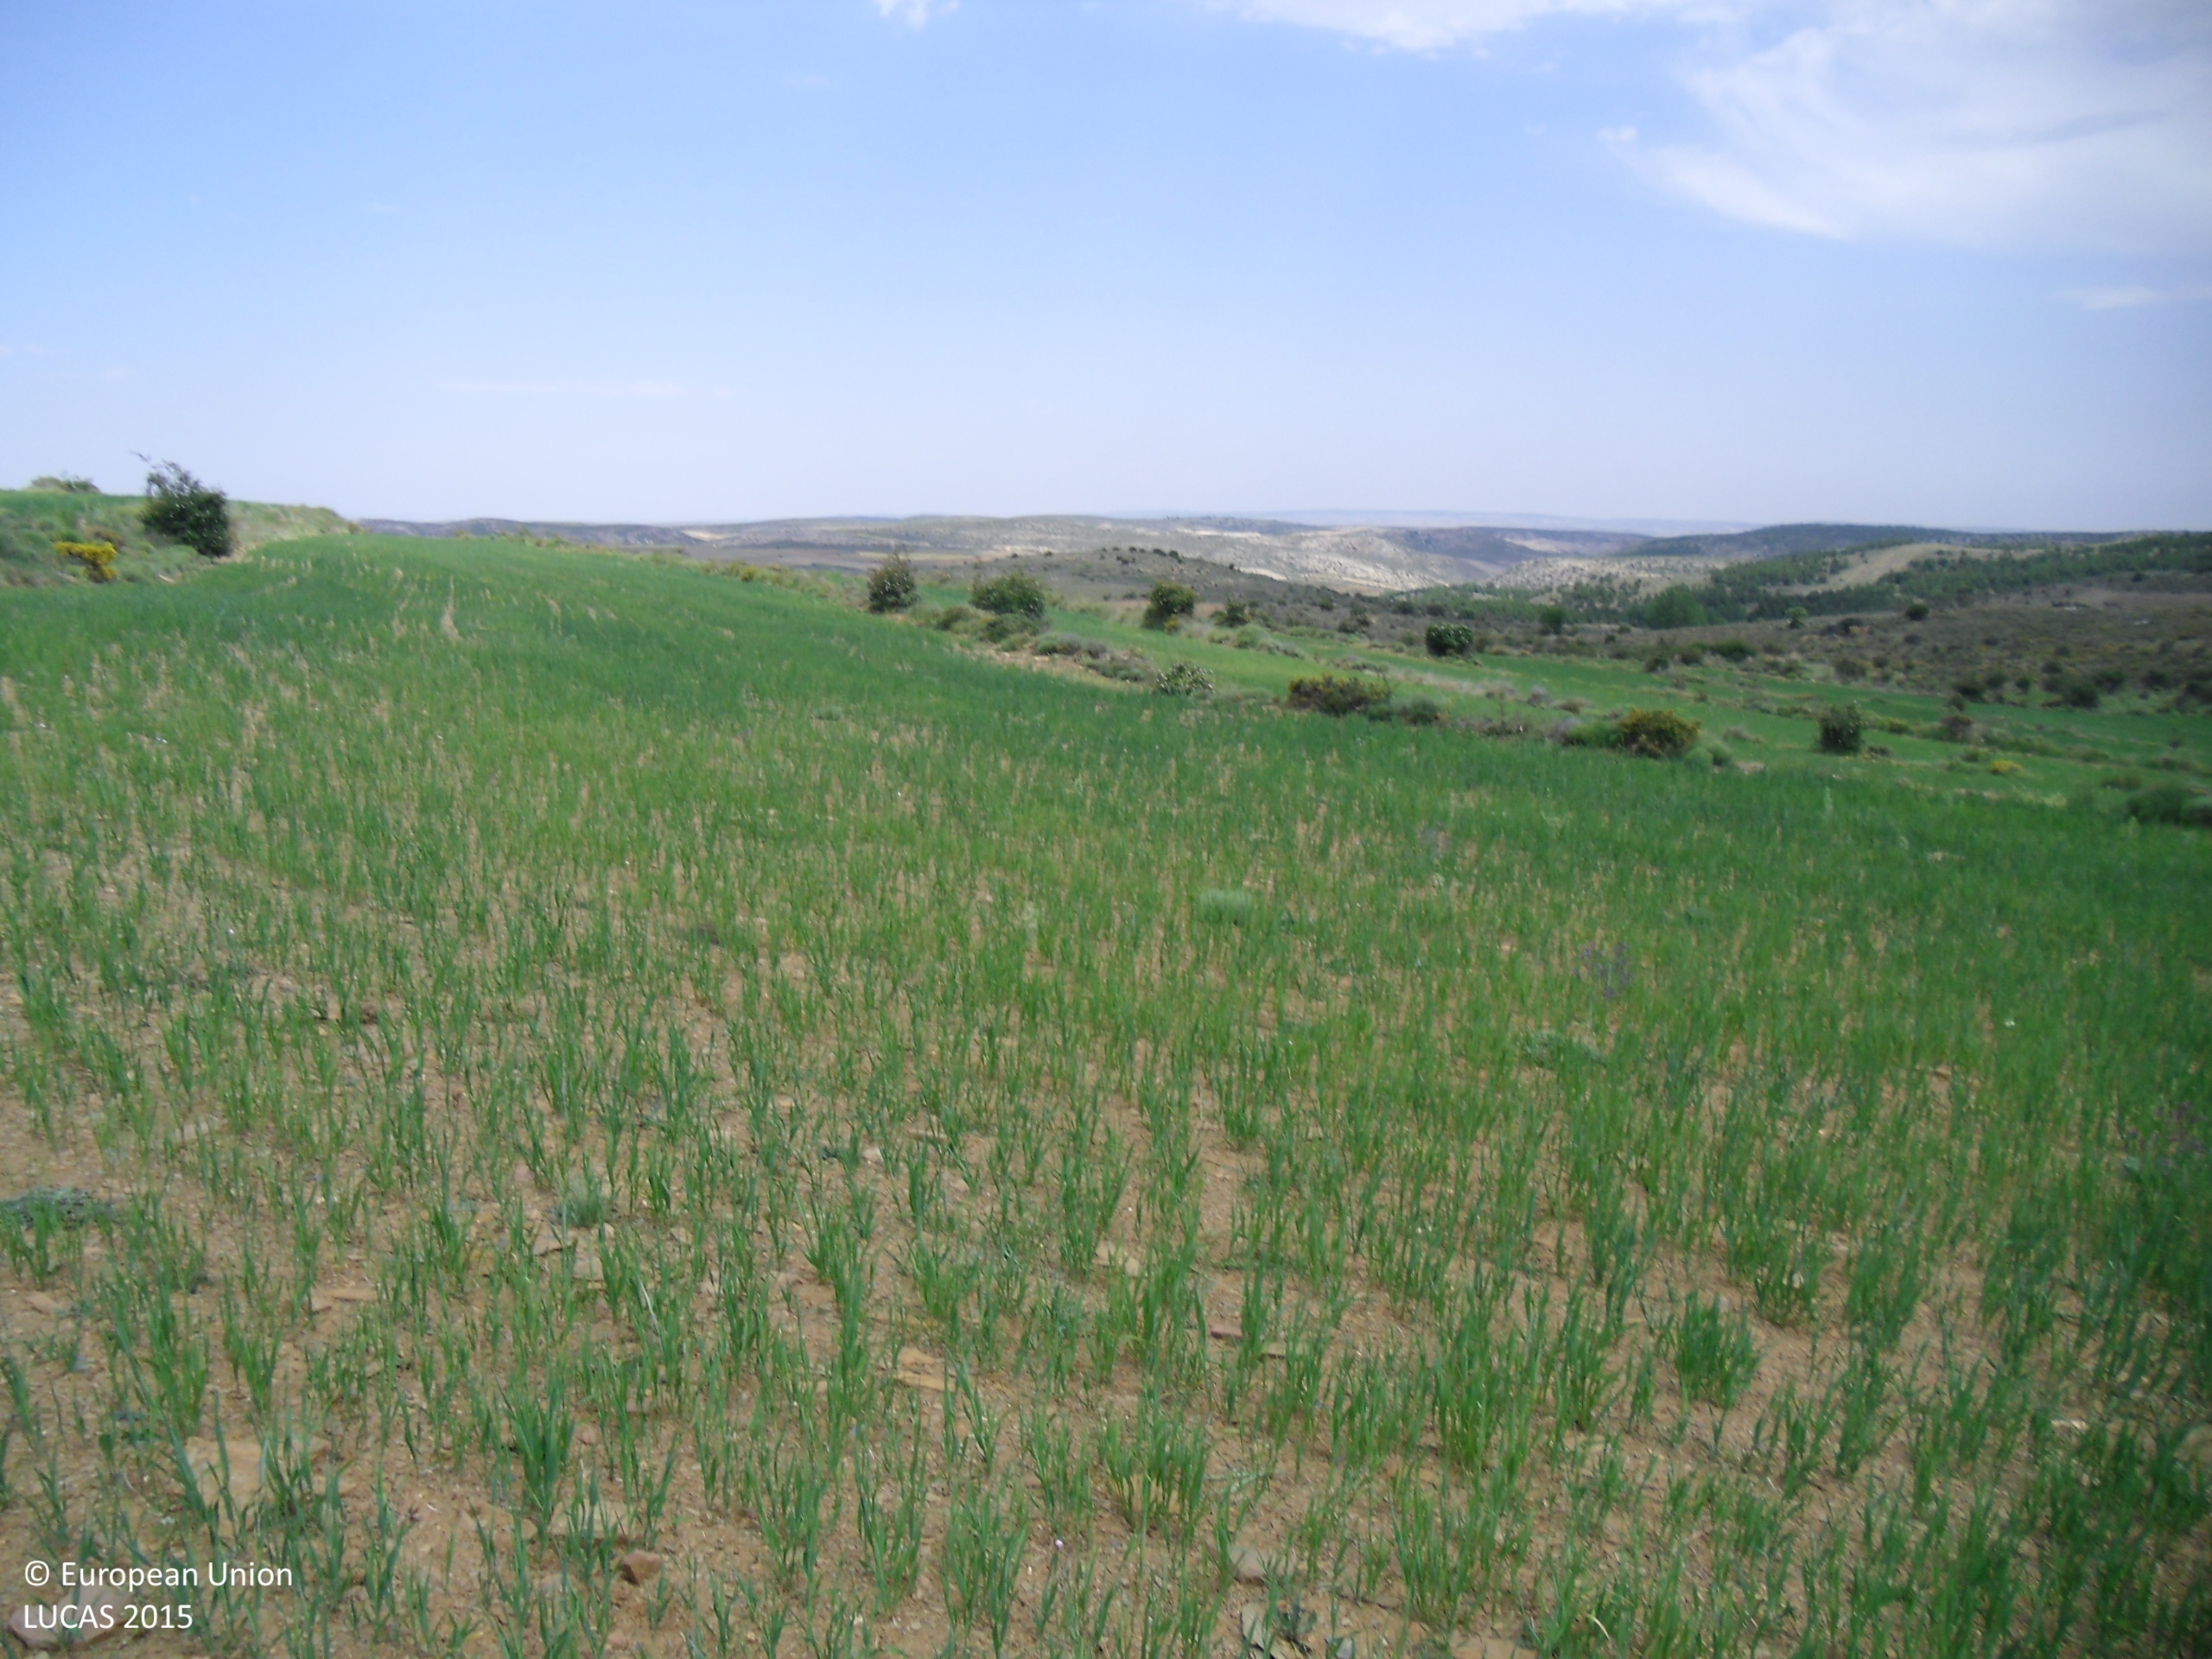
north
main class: Cropland
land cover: Barley
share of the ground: > 75 %
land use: Agriculture (excluding fallow land and kitchen gardens)
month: May
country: ES
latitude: 40.8880
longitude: -0.8263
